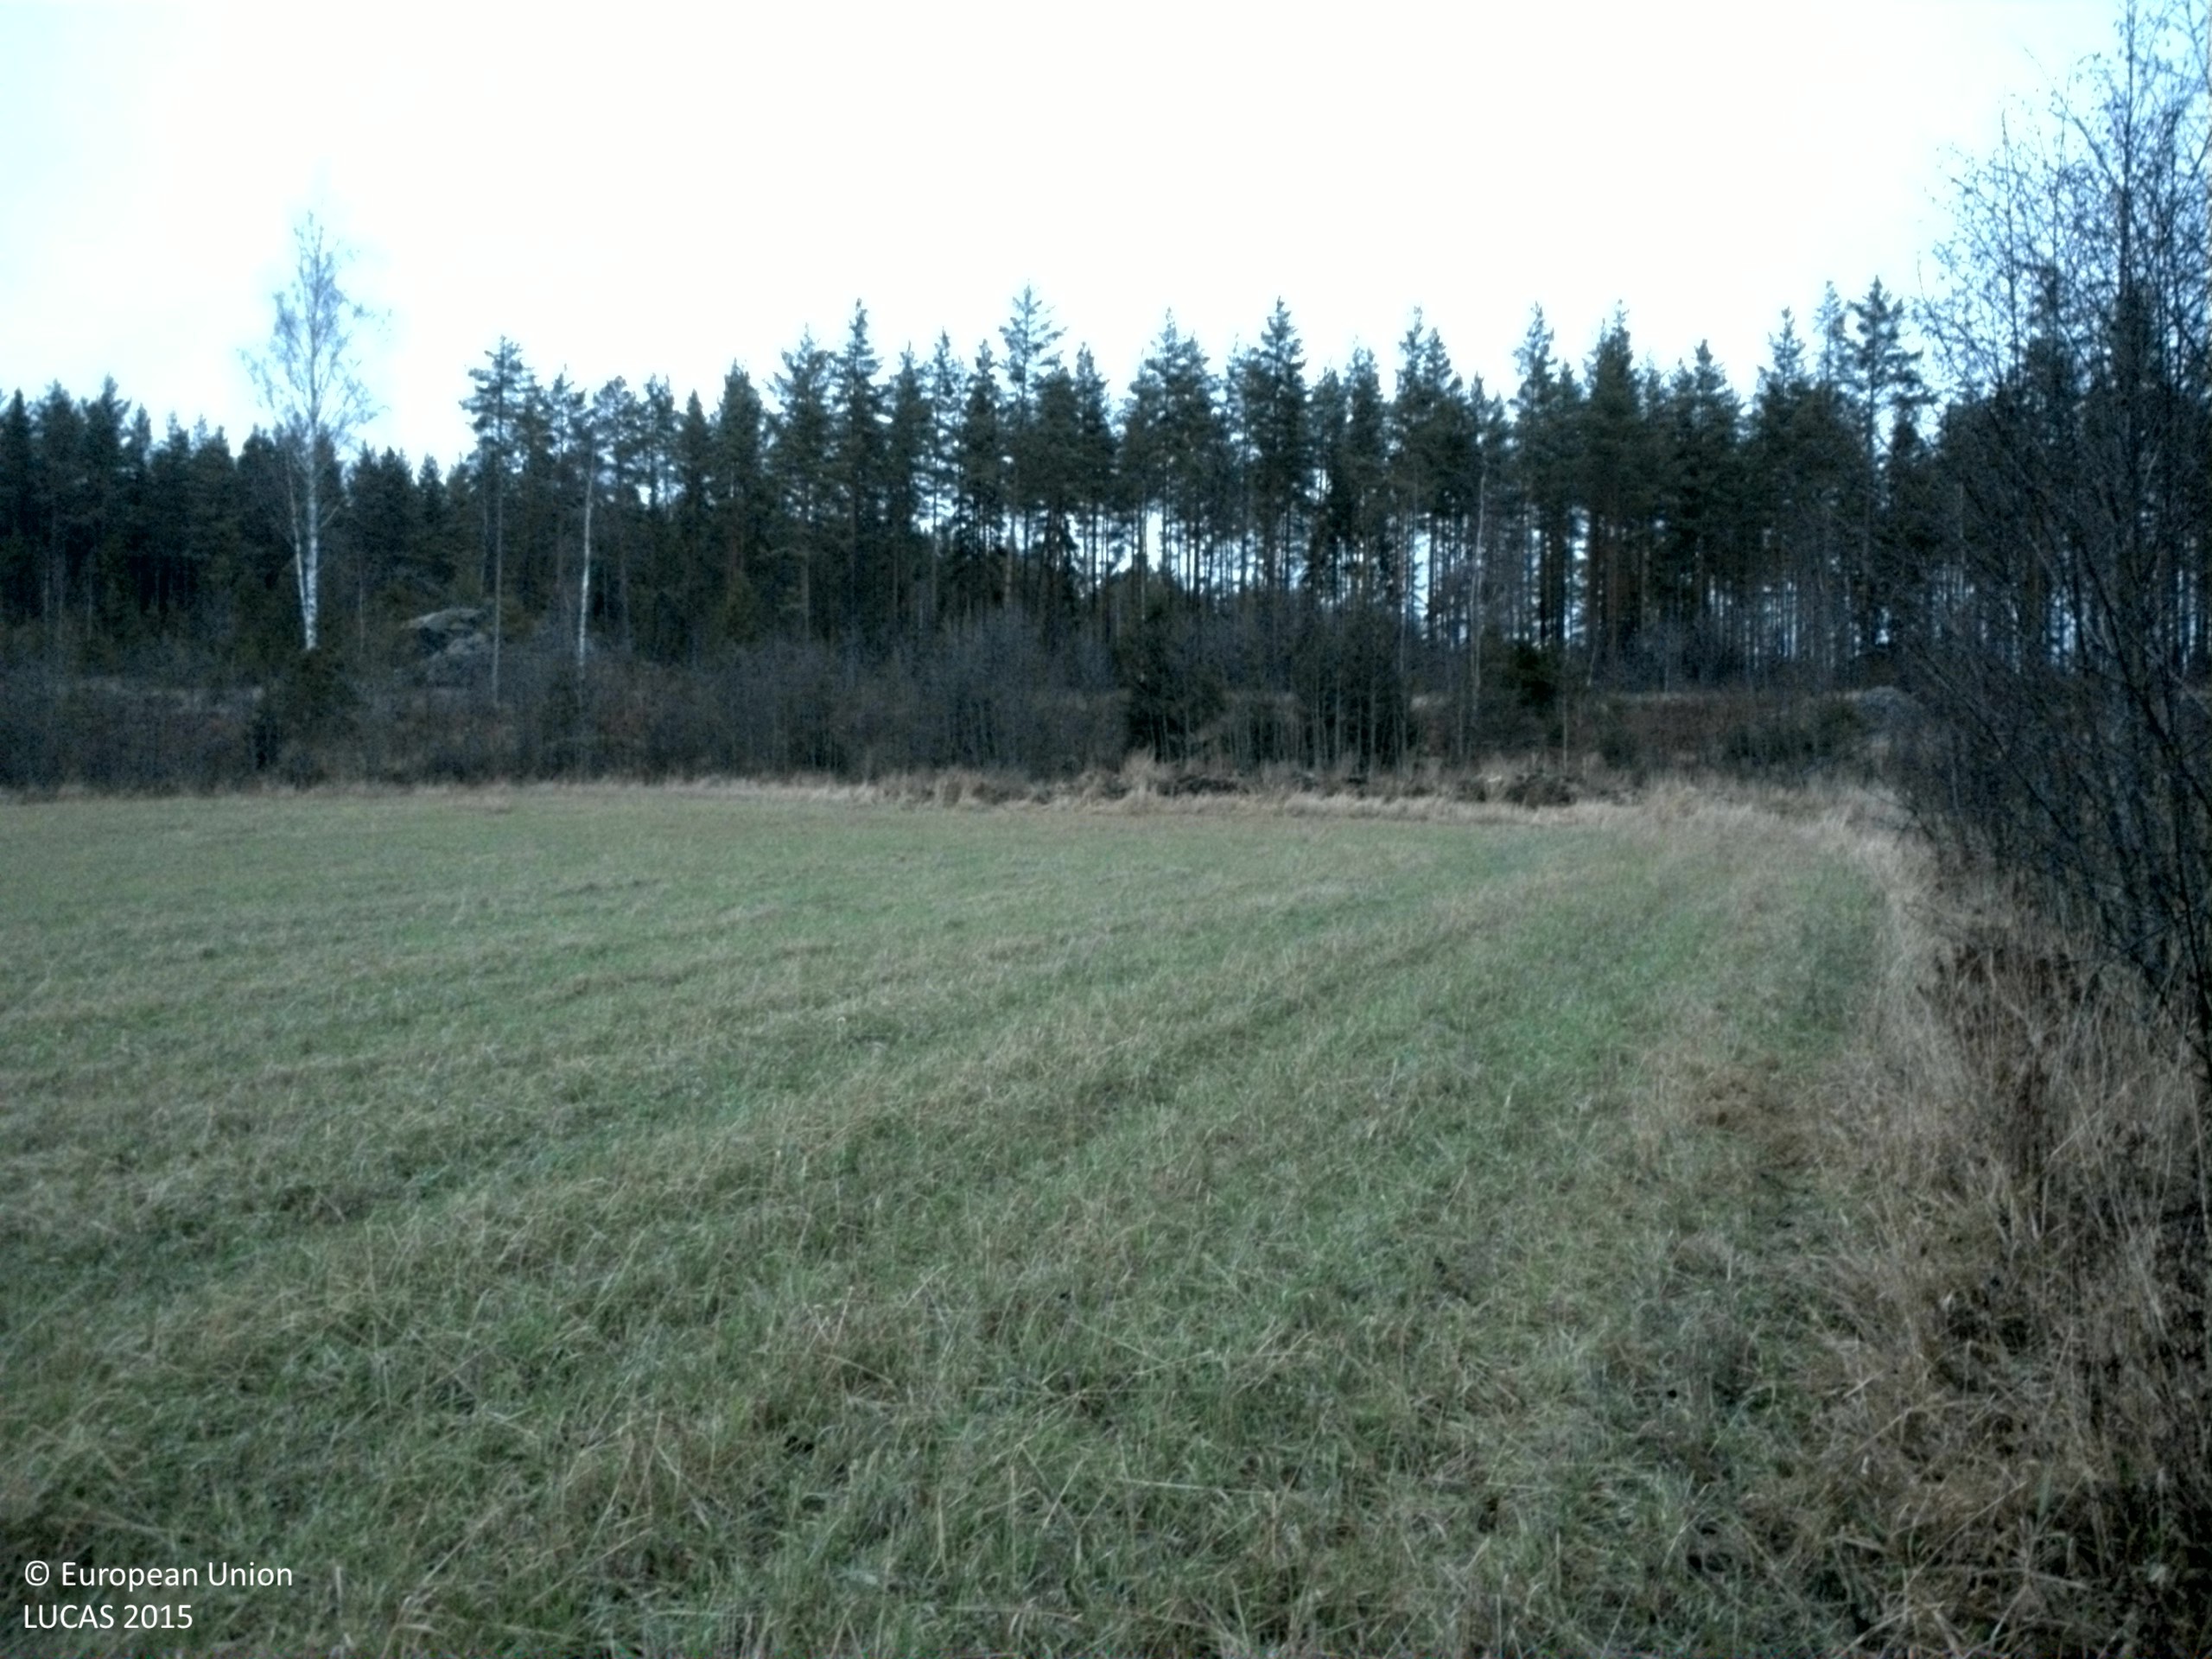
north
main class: Cropland
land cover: Other leguminous and mixtures for fodder
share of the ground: > 75 %
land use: Agriculture (excluding fallow land and kitchen gardens)
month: November
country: SE
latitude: 61.4923
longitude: 16.9529
